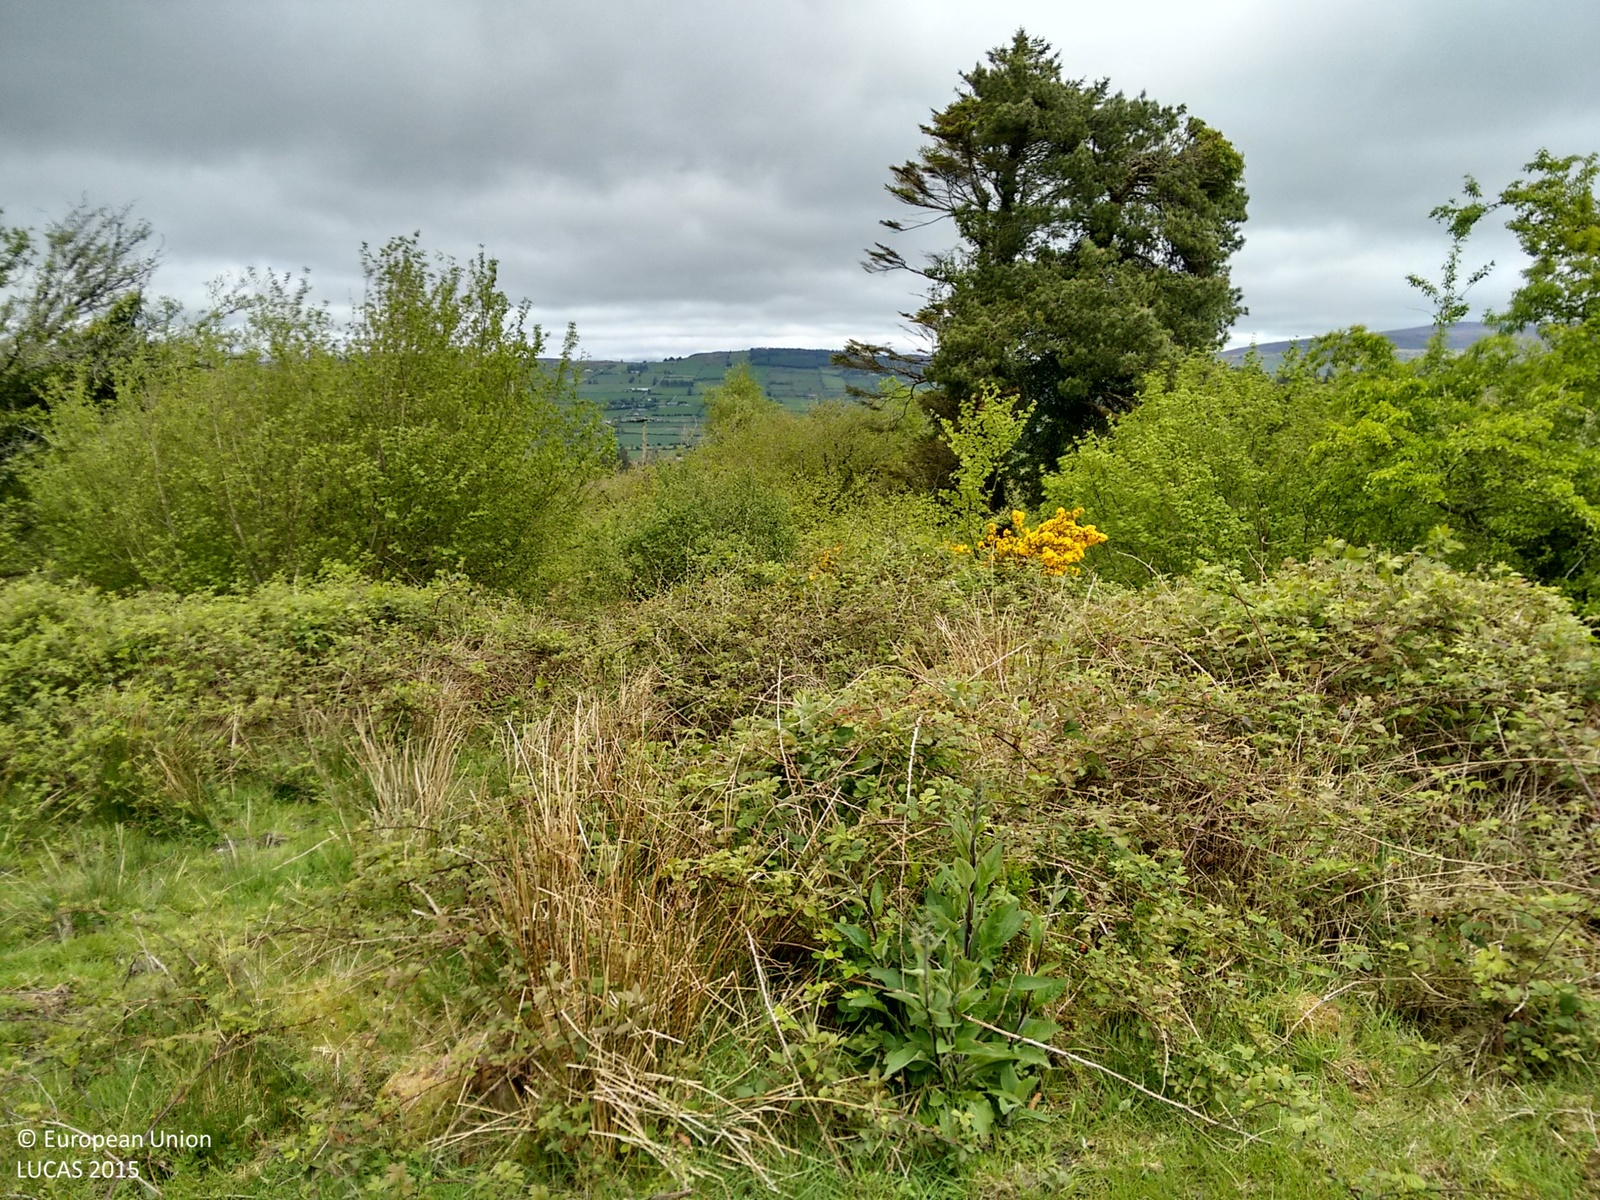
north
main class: Grassland
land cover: Grassland without tree/shrub cover
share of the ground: > 75 %
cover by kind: herbaceous plants 100 %
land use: Agriculture (excluding fallow land and kitchen gardens)
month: May
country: IE
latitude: 52.1870
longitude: -8.0976
